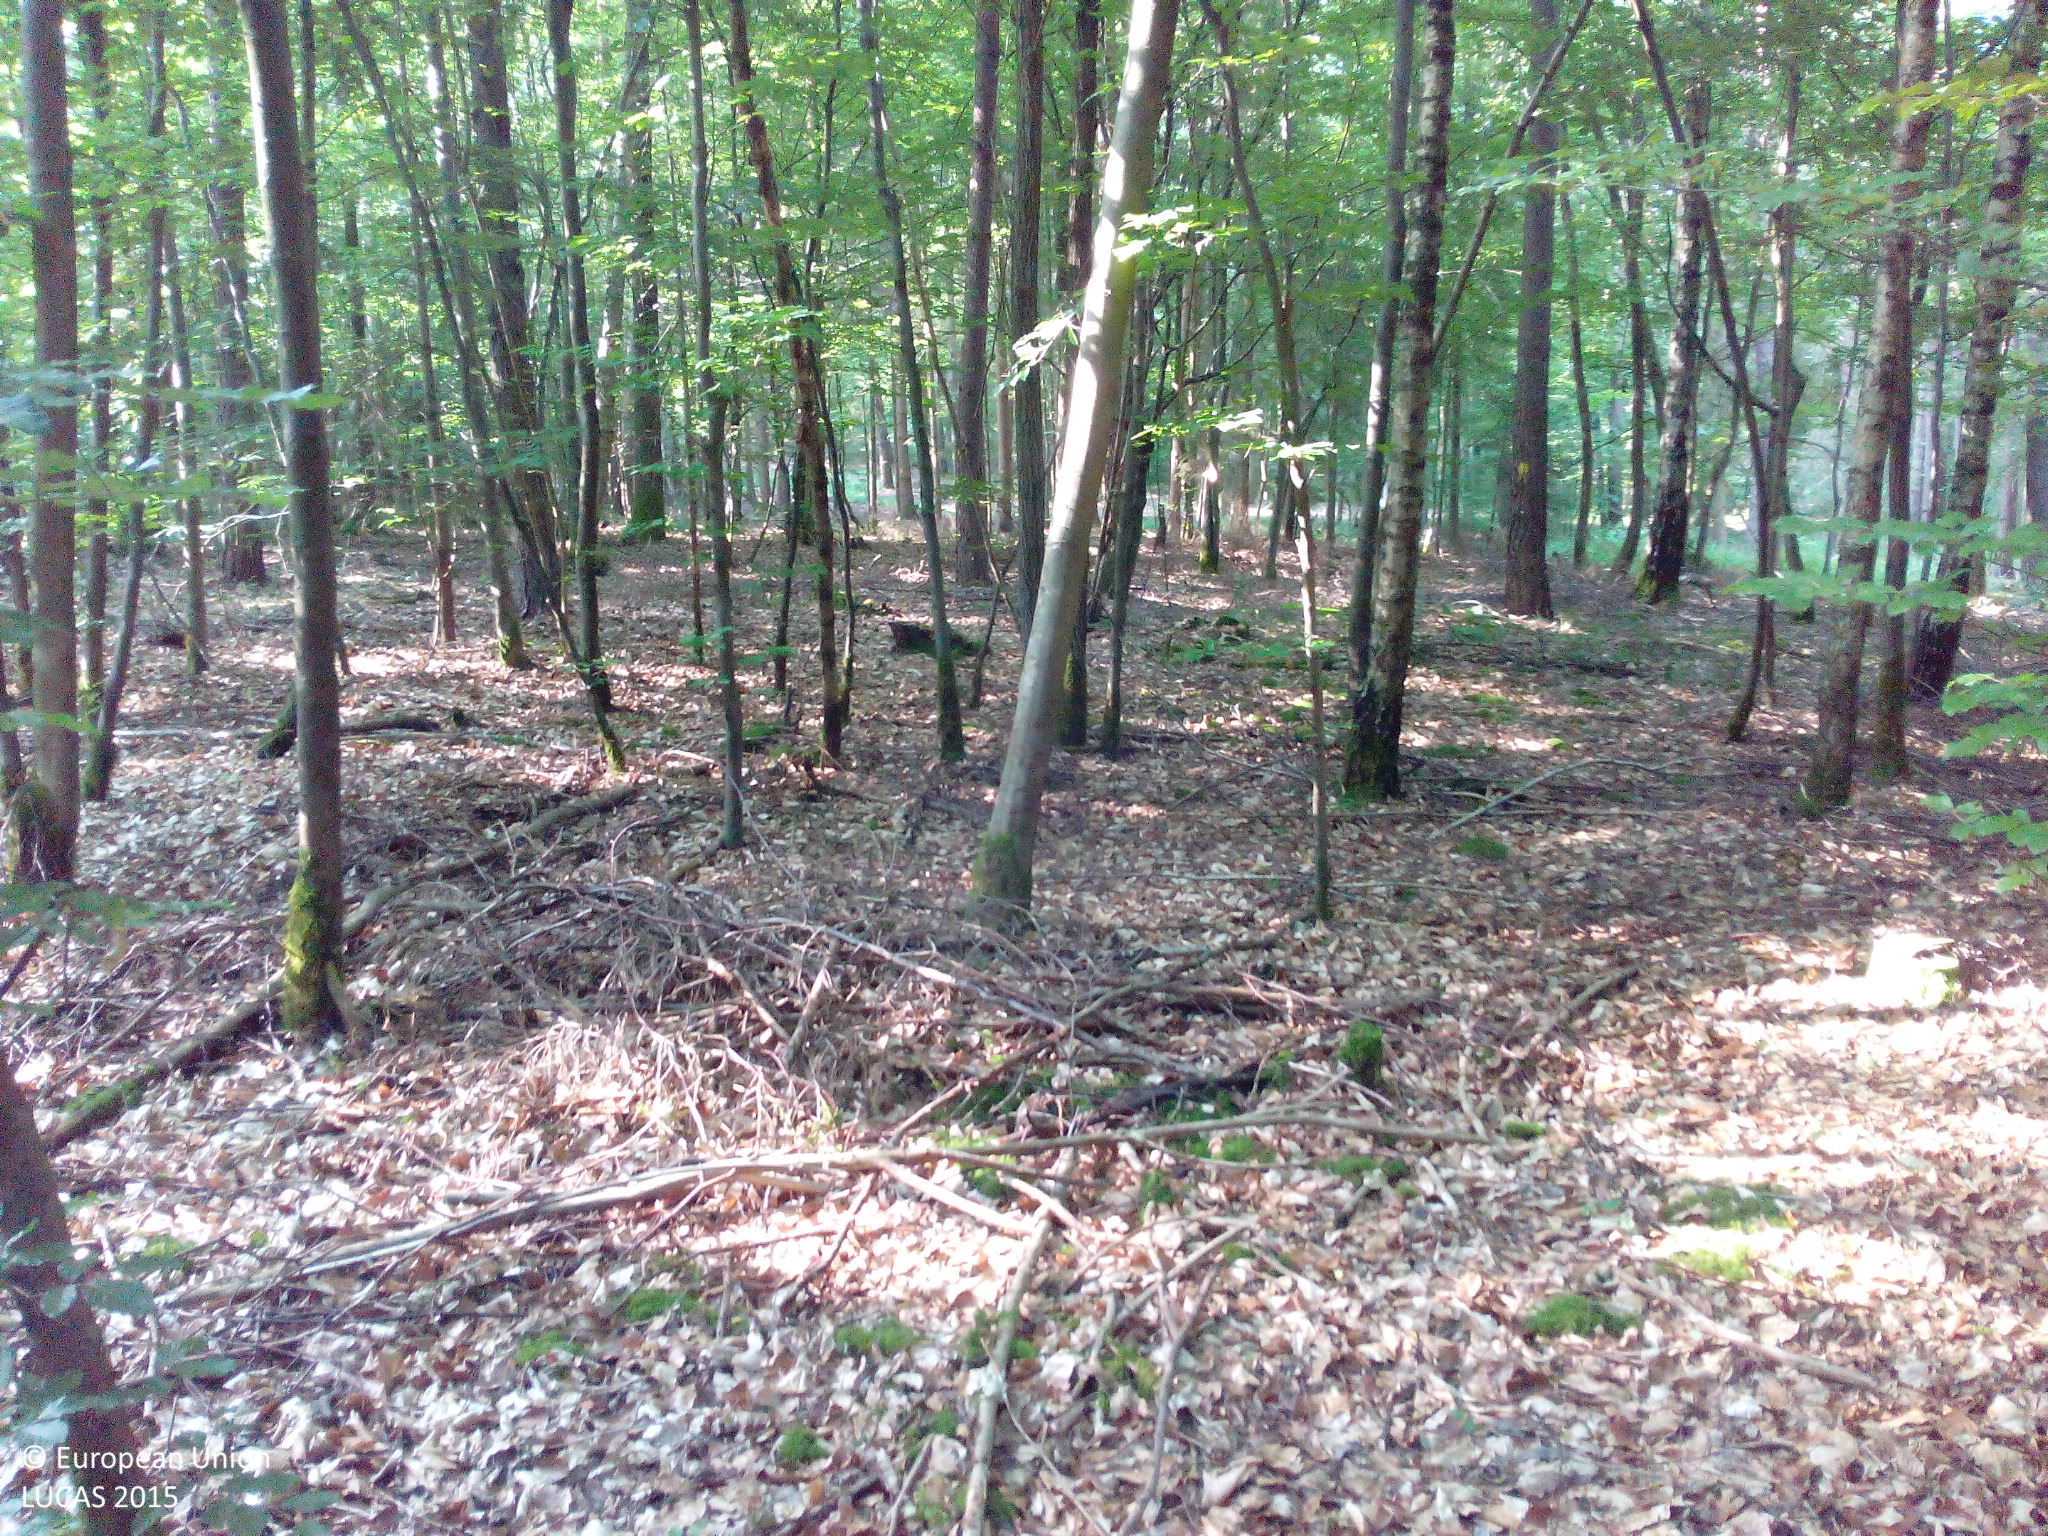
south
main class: Woodland
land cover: Pine dominated mixed woodland
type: hemiboreal forest and nemoral coniferous forest and mixed broadleaved-coniferous forest
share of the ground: > 75 %
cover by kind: broadleaved forest trees 70 %, coniferous forest trees 25 %, unconsolidated bare surface 5 %
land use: Forestry
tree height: > 5 m
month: July
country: DE
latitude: 49.8207
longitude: 10.9309
